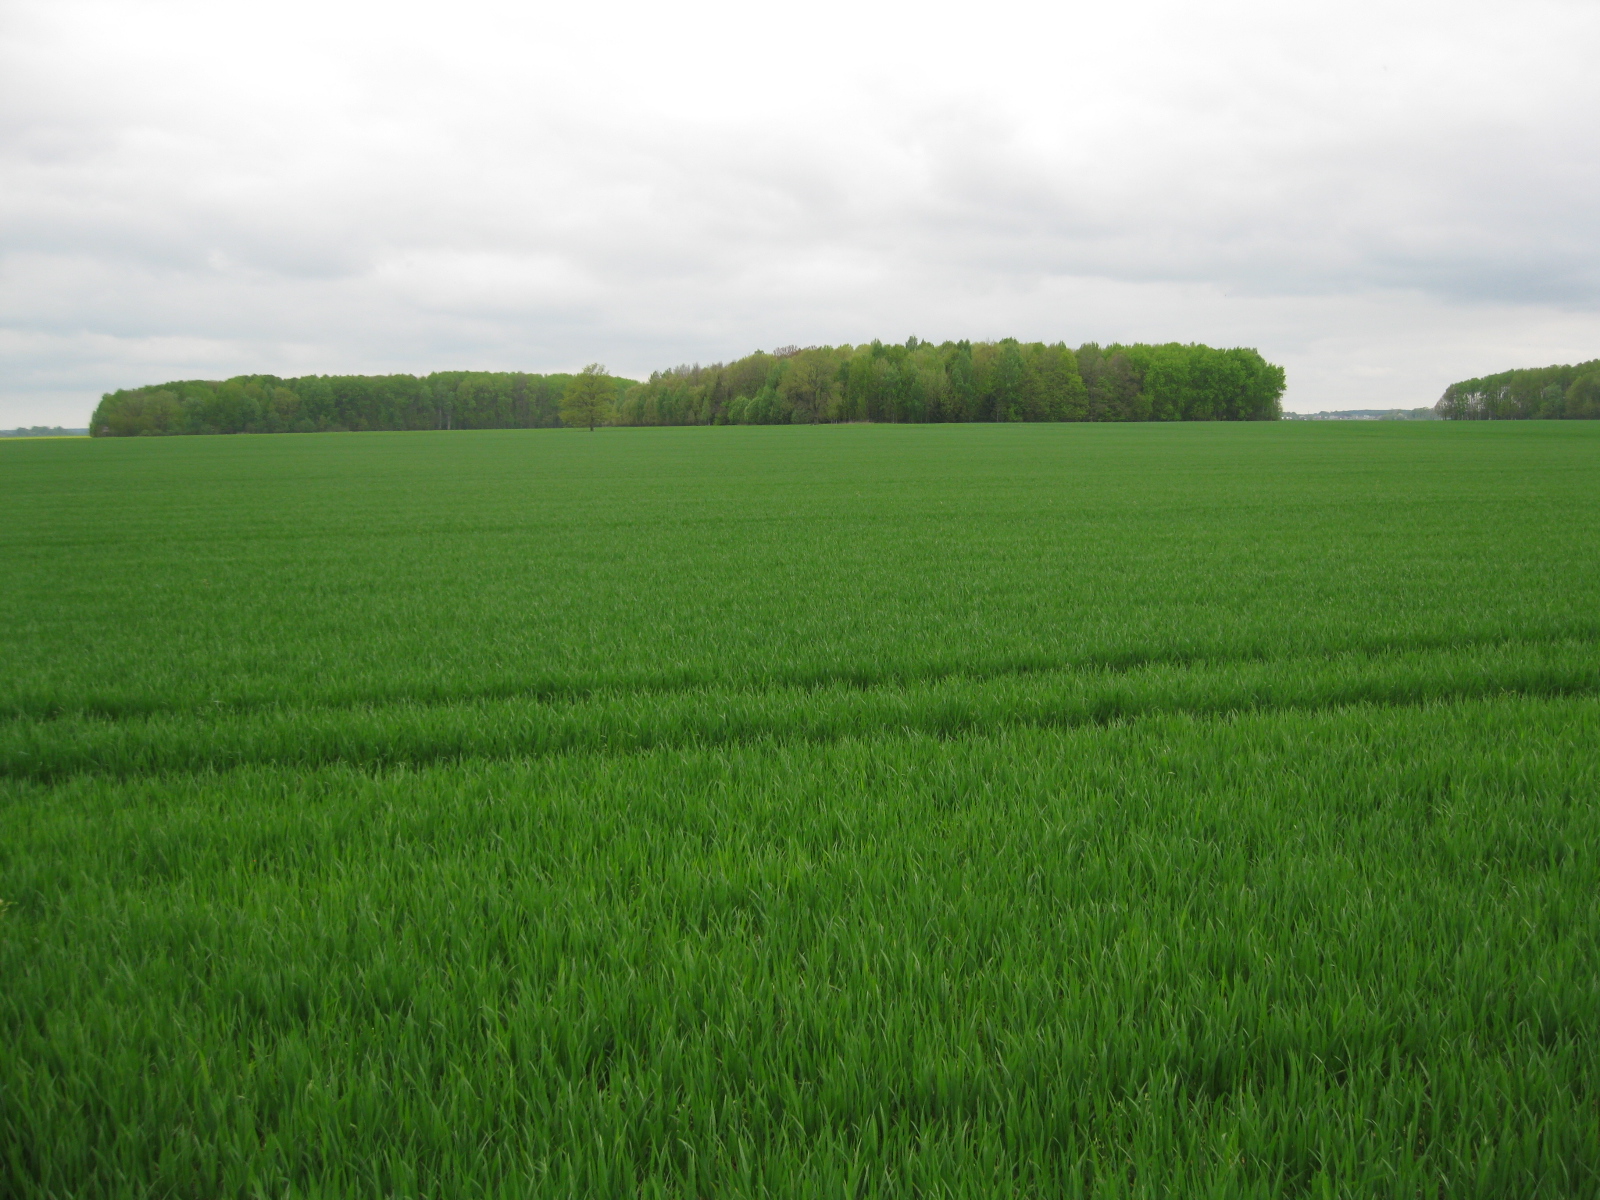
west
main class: Cropland
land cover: Common wheat
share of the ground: > 75 %
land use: Agriculture (excluding fallow land and kitchen gardens)
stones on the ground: < 10 %
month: May
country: LT
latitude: 56.0079
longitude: 24.4182
